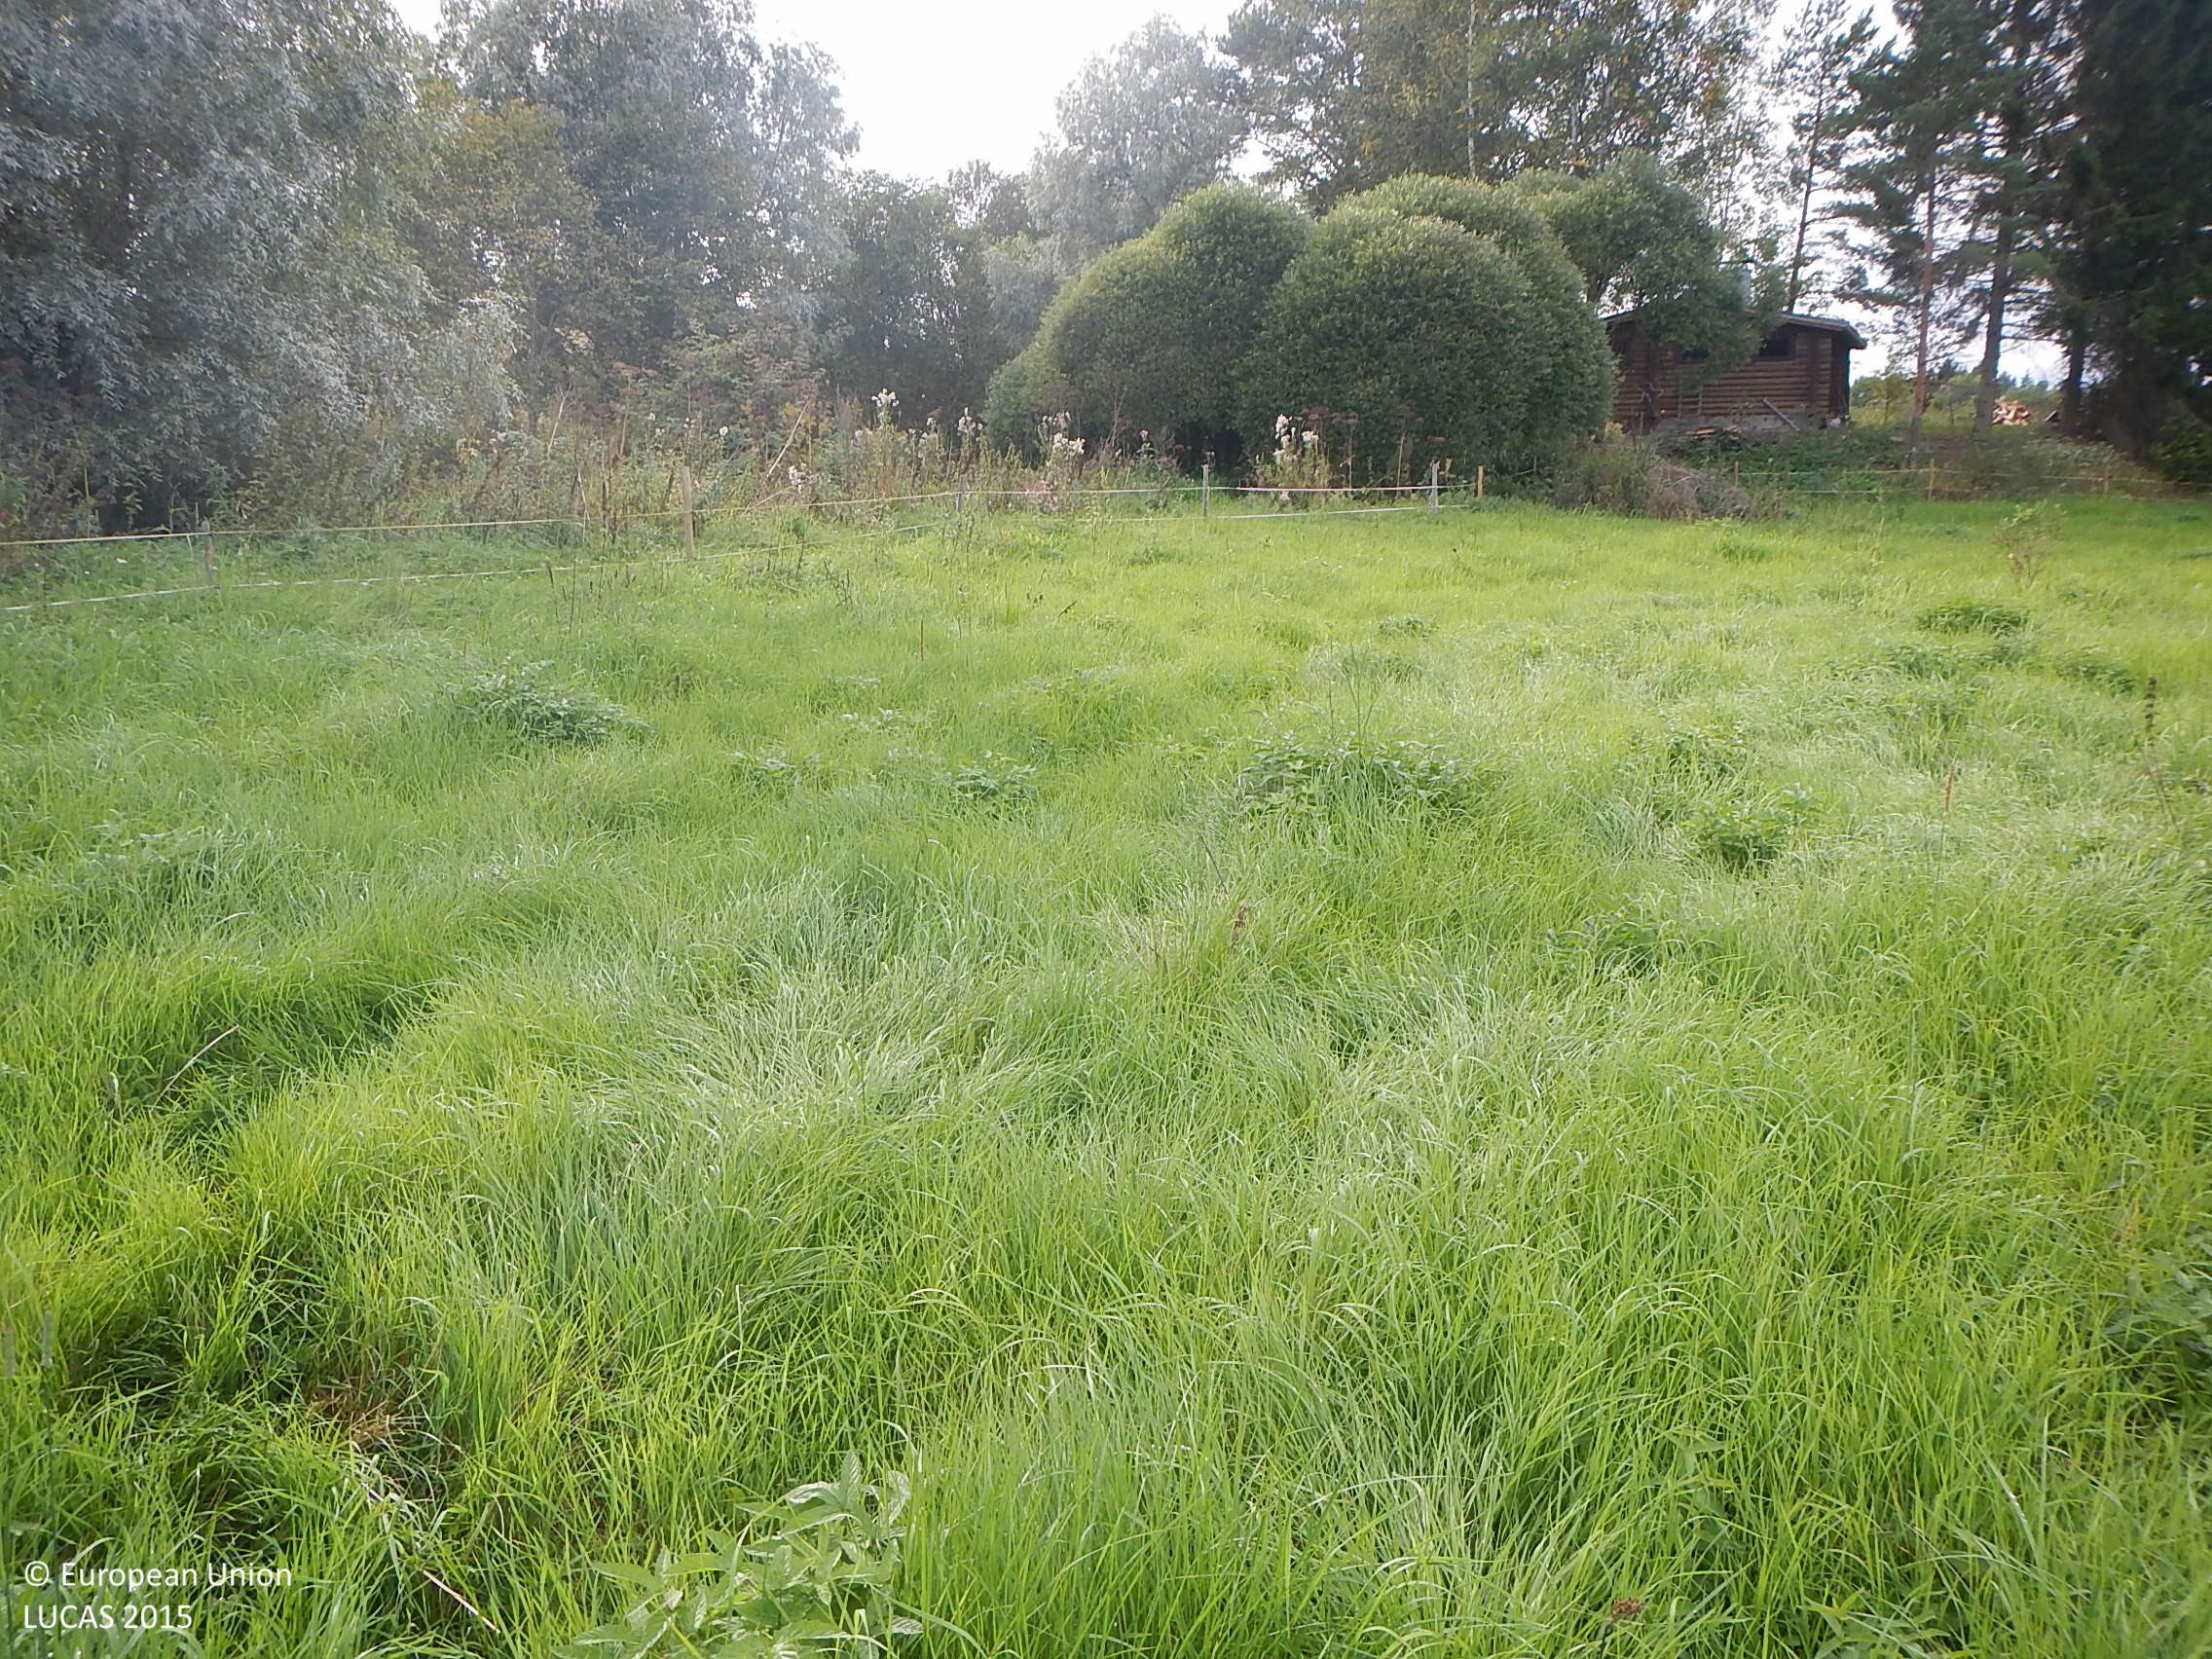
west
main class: Grassland
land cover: Grassland without tree/shrub cover
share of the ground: > 75 %
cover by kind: herbaceous plants 100 %
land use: Agriculture (excluding fallow land and kitchen gardens)
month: September
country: FI
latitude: 61.5162
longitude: 22.9838
